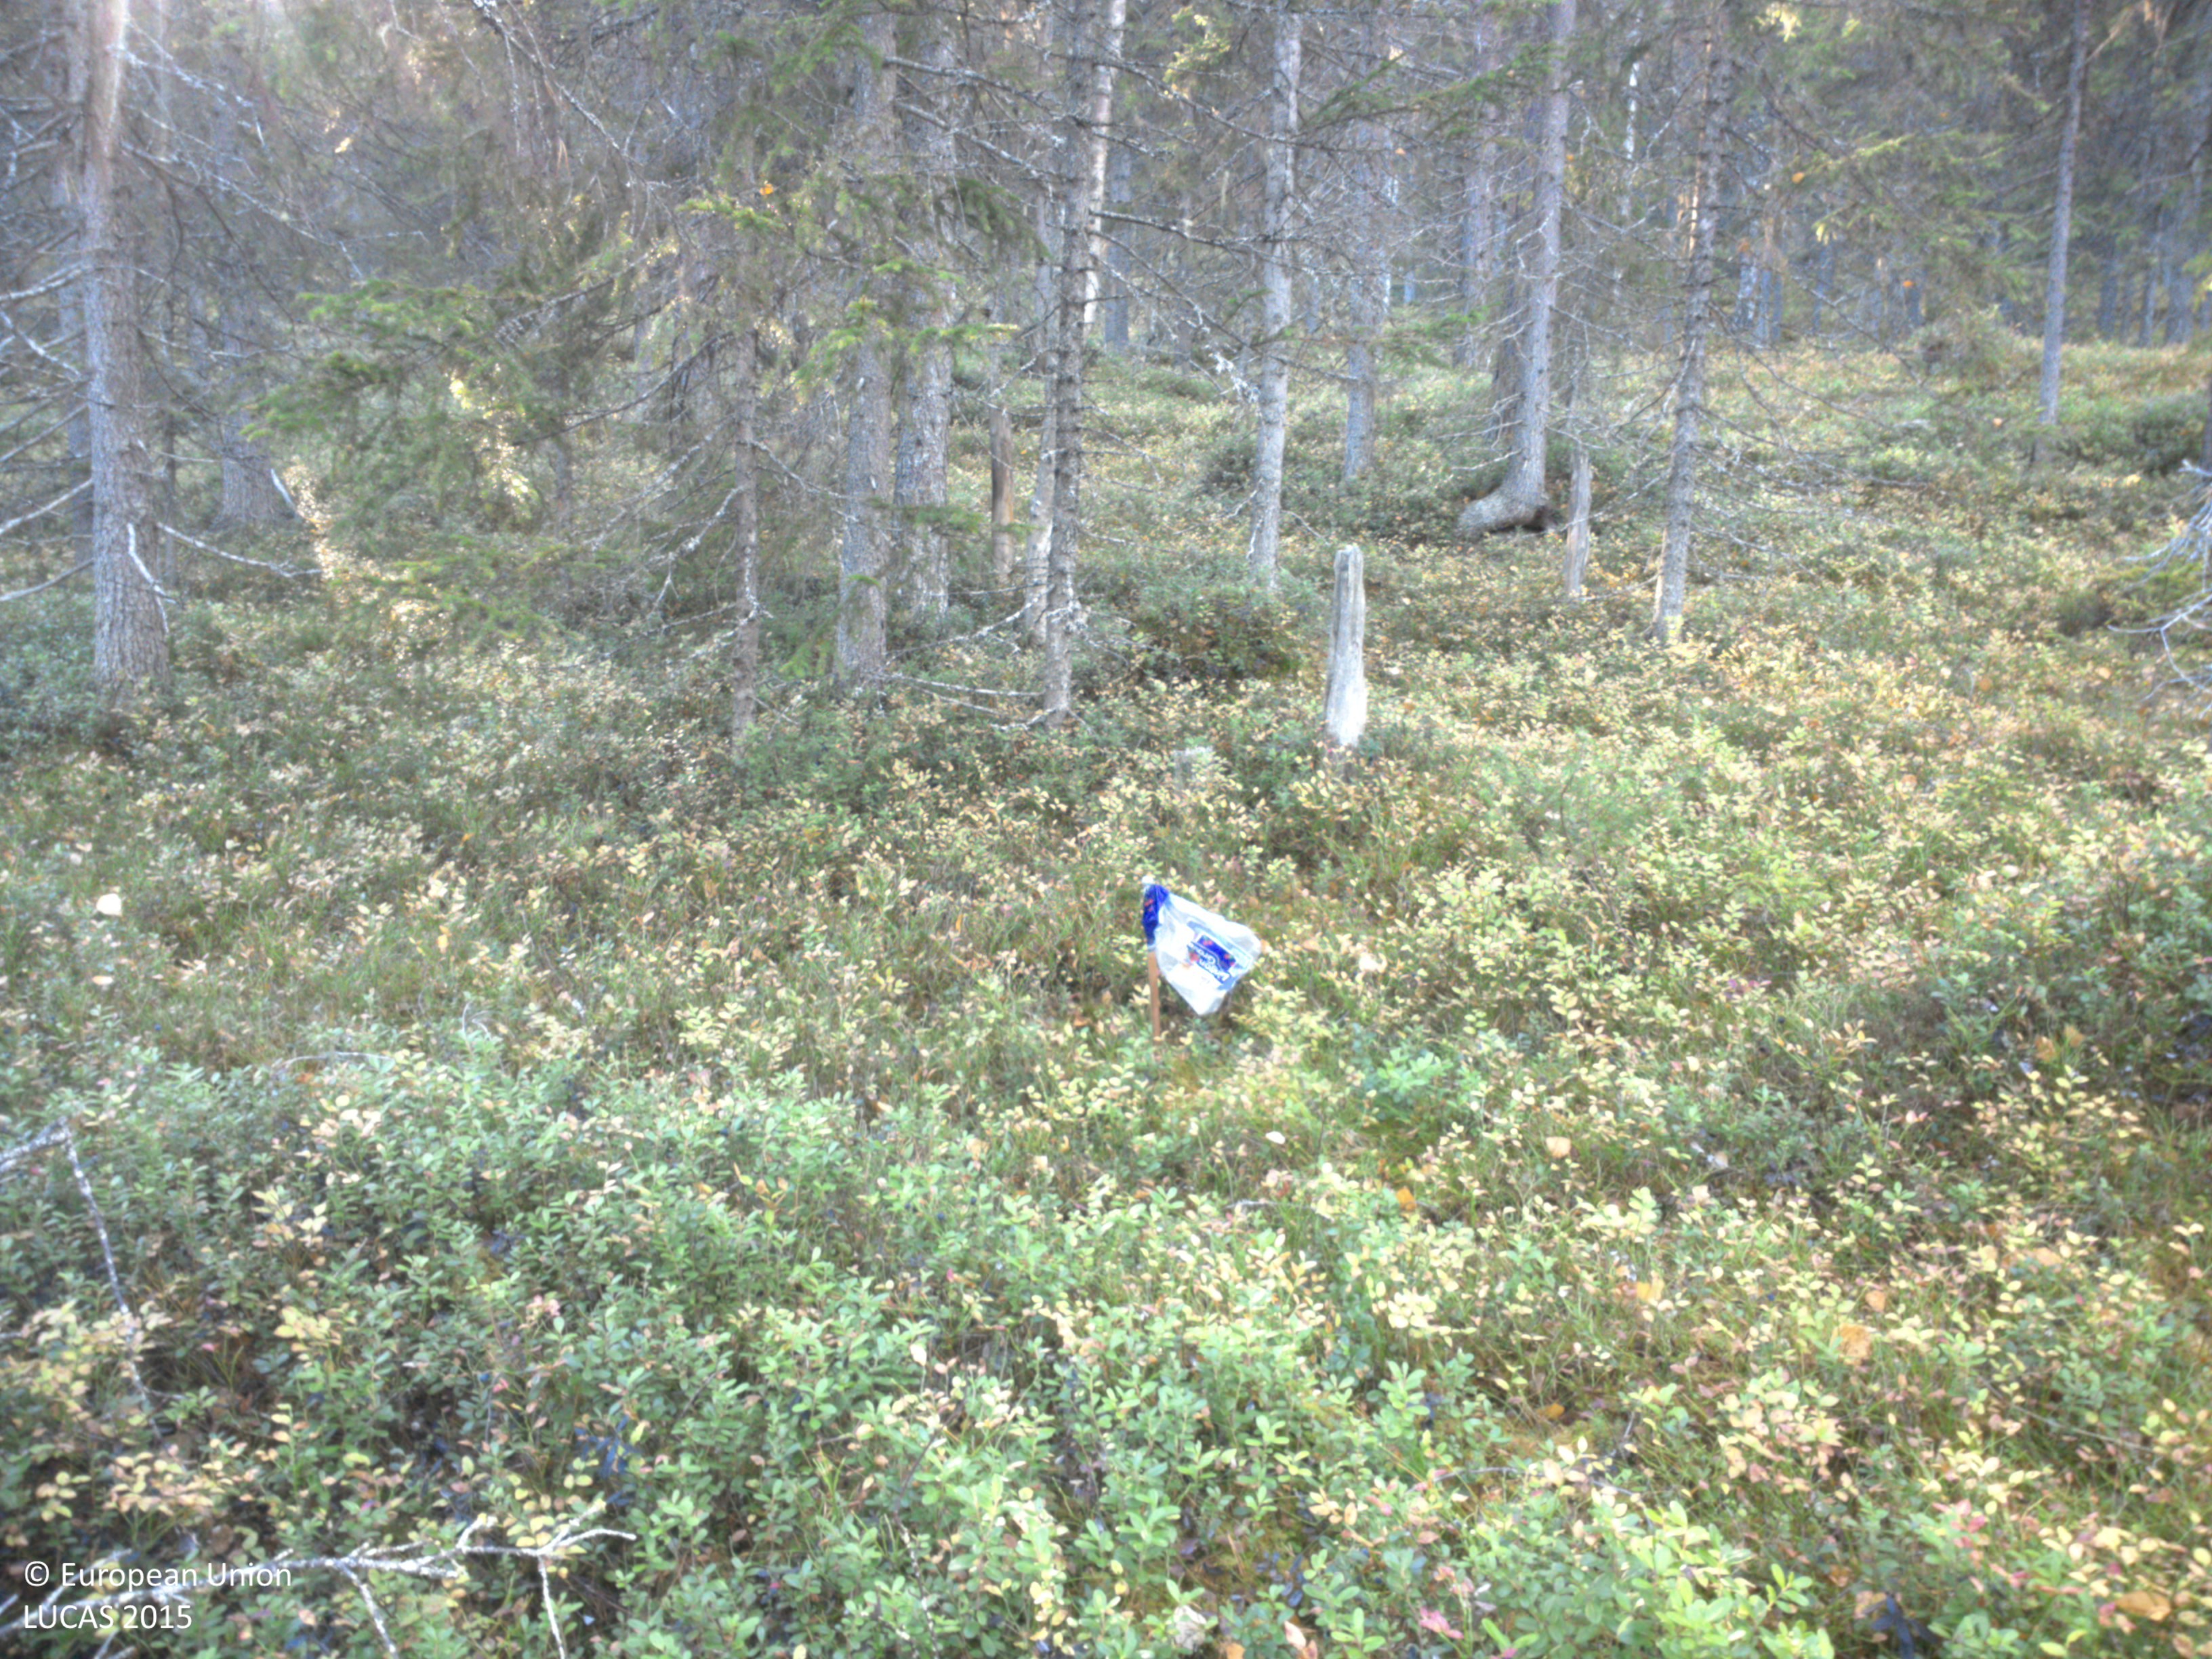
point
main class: Woodland
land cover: Other mixed woodland
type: boreal forest
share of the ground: > 75 %
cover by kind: coniferous forest trees 60 %, broadleaved forest trees 25 %, shrubs 10 %, lichens and mosses 5 %
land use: Forestry
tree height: > 5 m
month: October
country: SE
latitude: 64.7776
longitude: 18.3576
